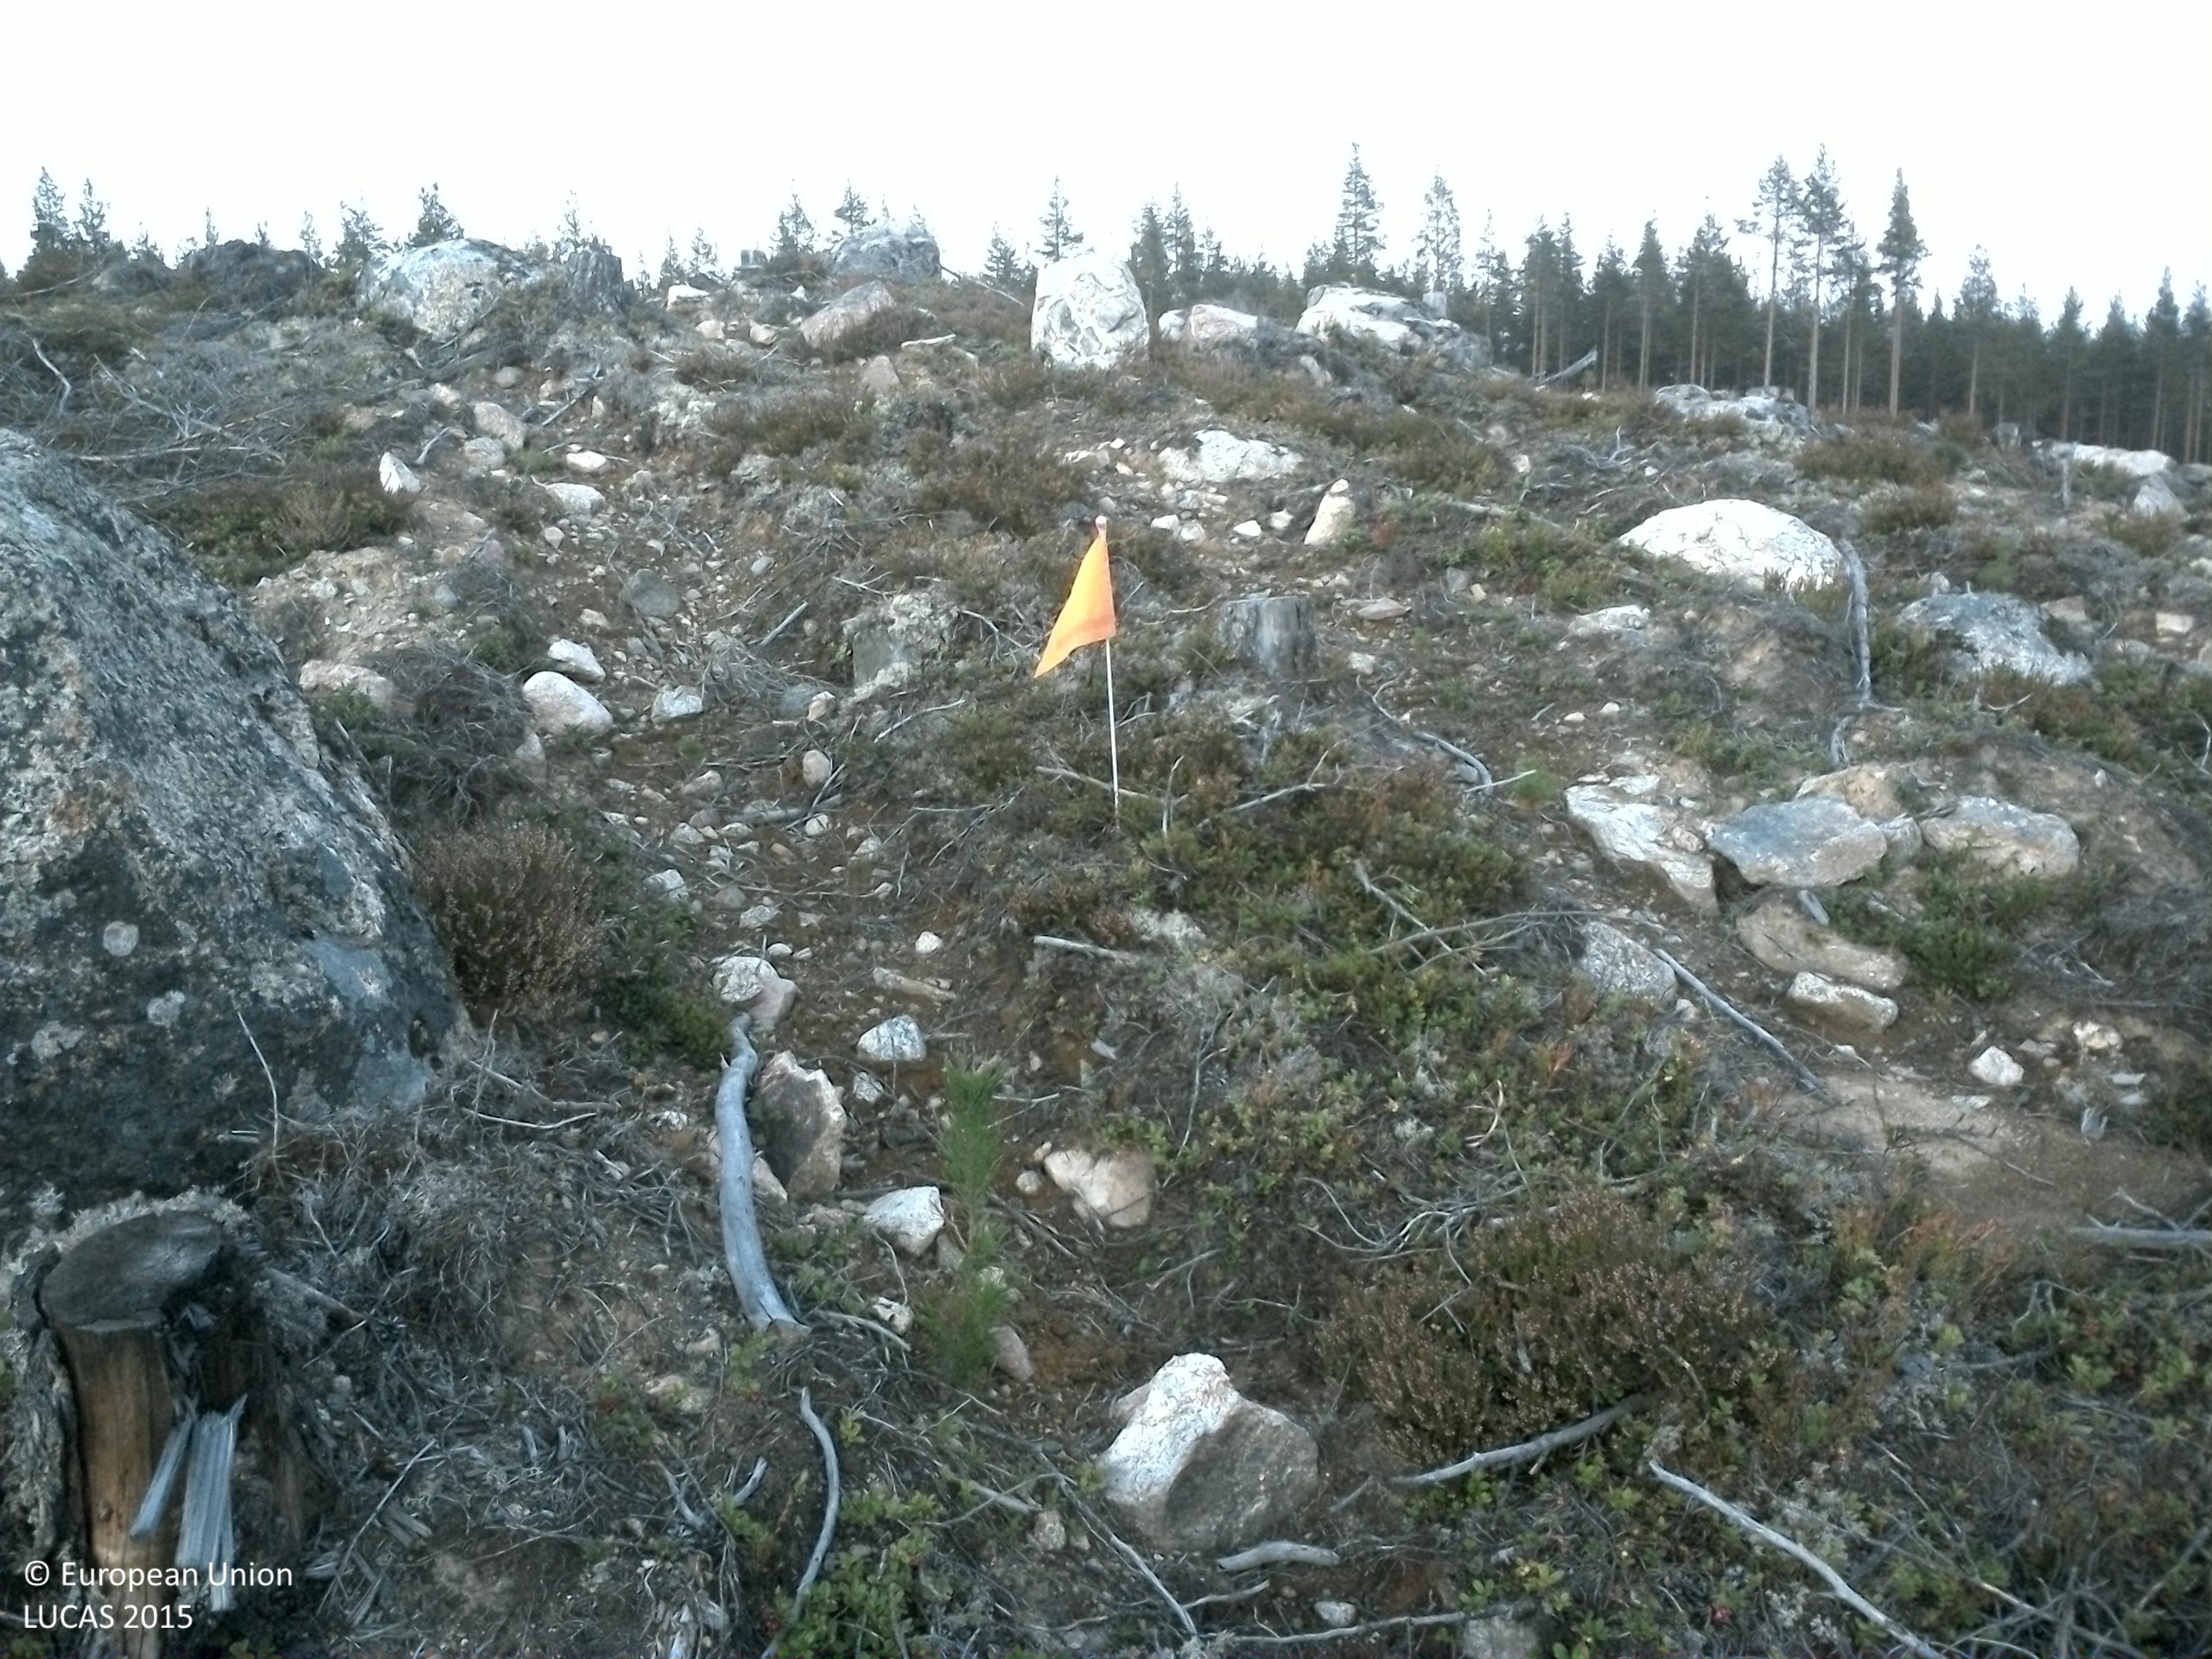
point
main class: Shrubland
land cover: Shrubland without tree cover
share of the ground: 50 - 75 %
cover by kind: shrubs 50 %, consolidated bare surface 40 %, lichens and mosses 10 %
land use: Forestry
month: September
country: SE
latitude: 61.5943
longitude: 15.3918
